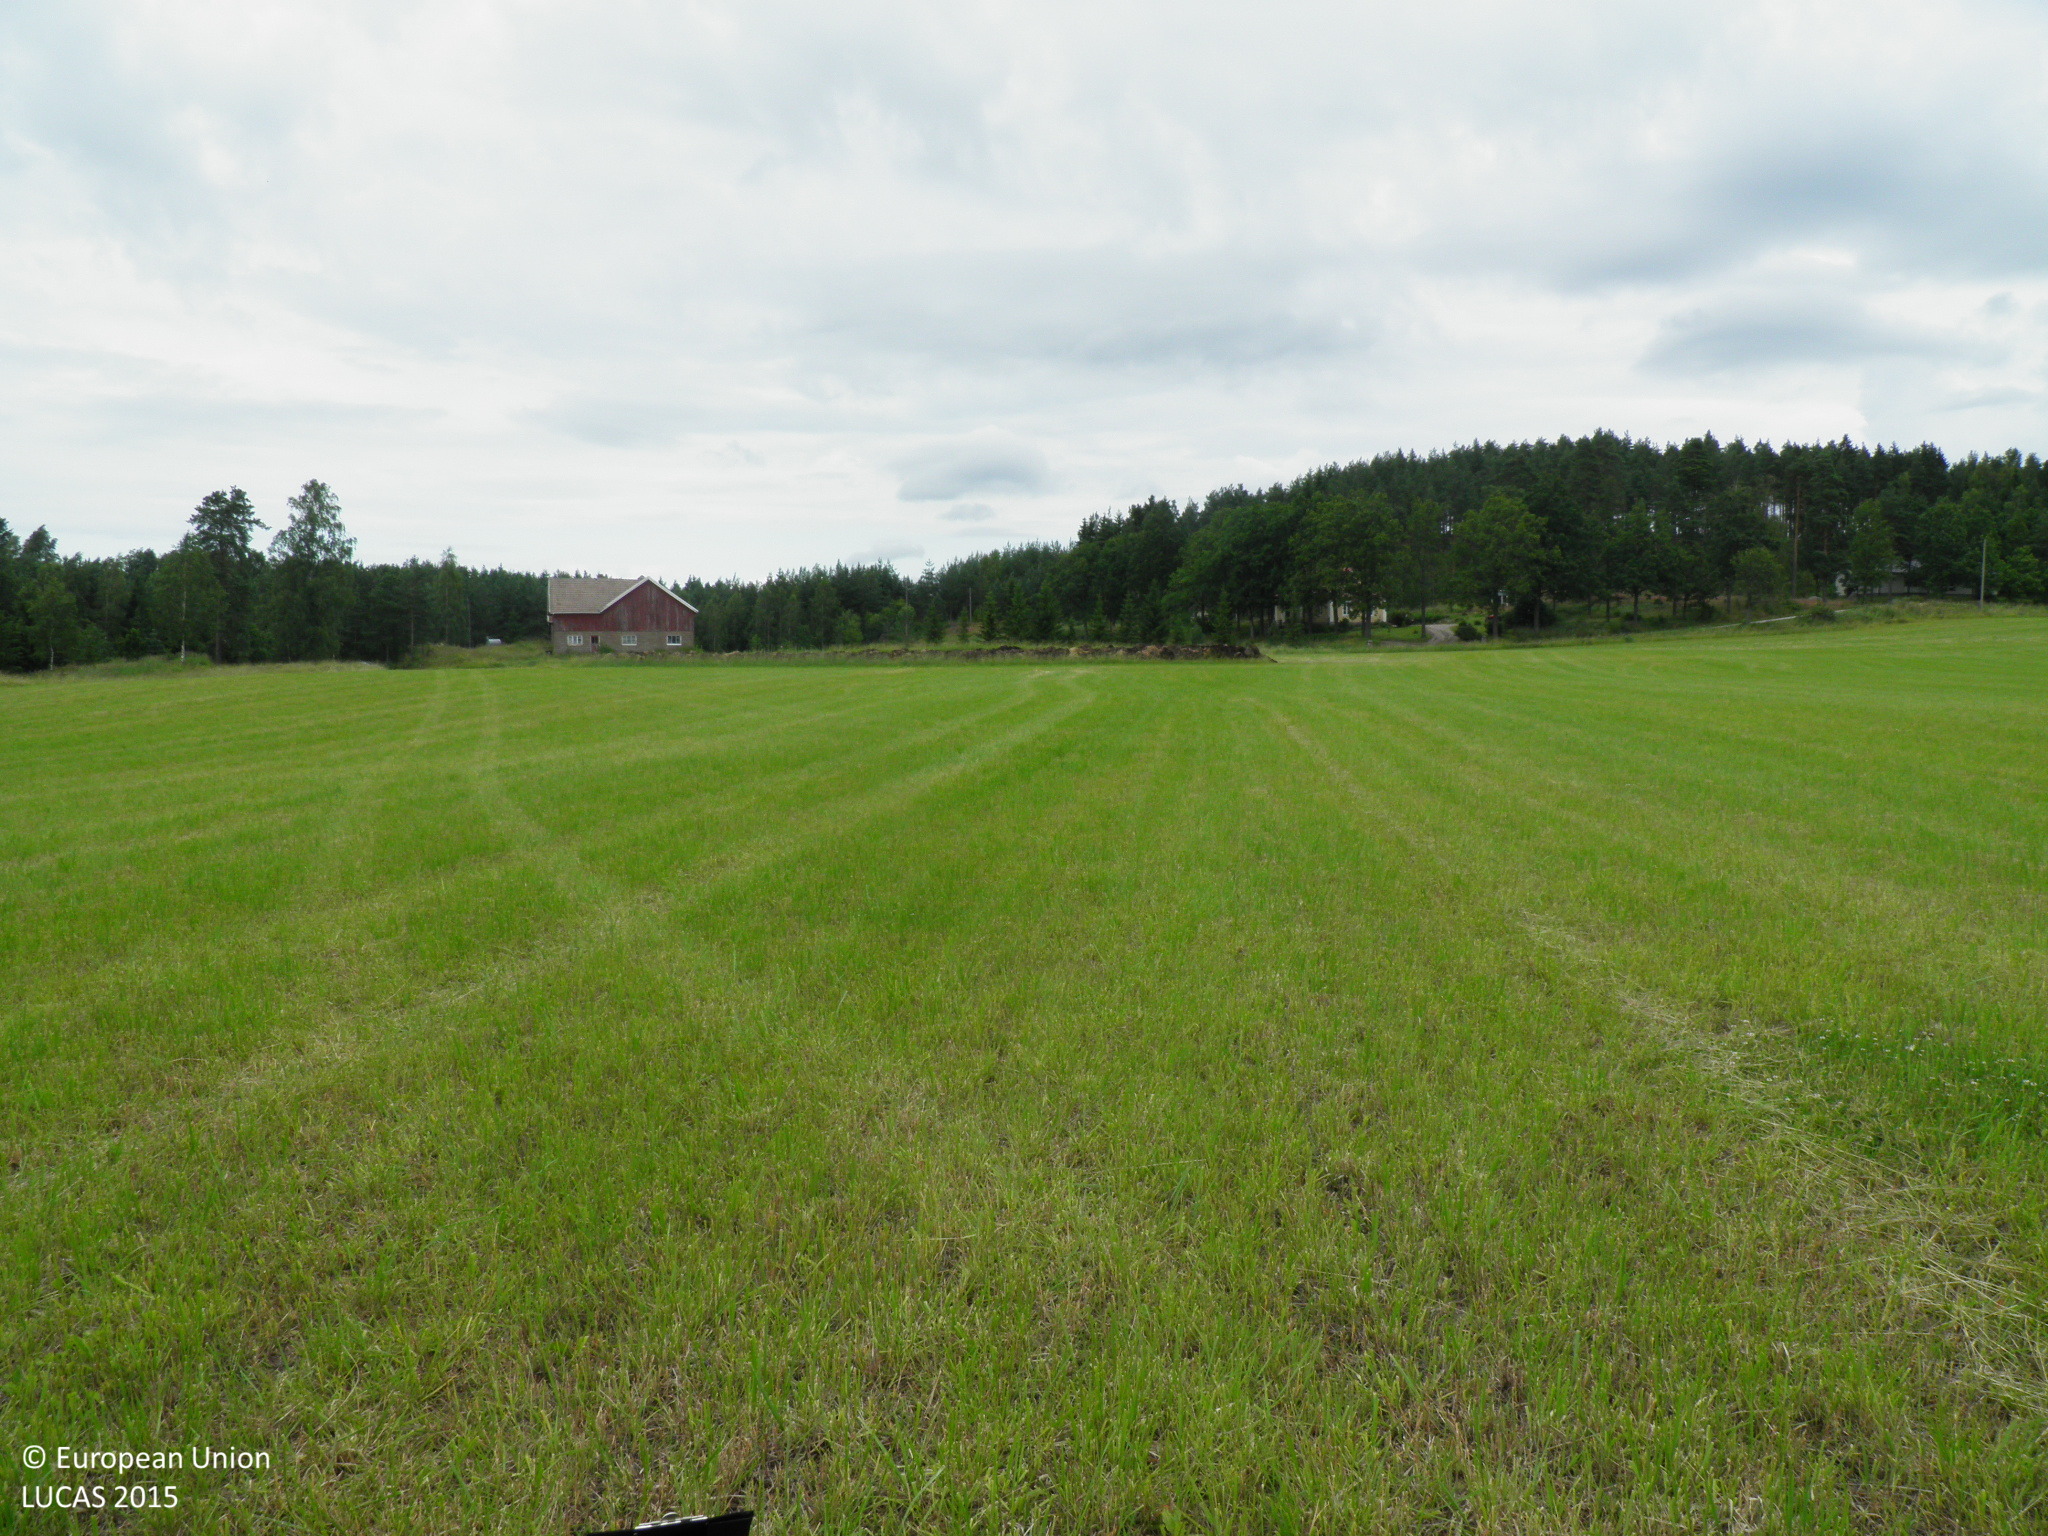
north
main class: Cropland
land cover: Temporary grasslands
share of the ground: > 75 %
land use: Agriculture (excluding fallow land and kitchen gardens)
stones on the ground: < 10 %
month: July
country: FI
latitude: 60.1868
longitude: 22.7159
